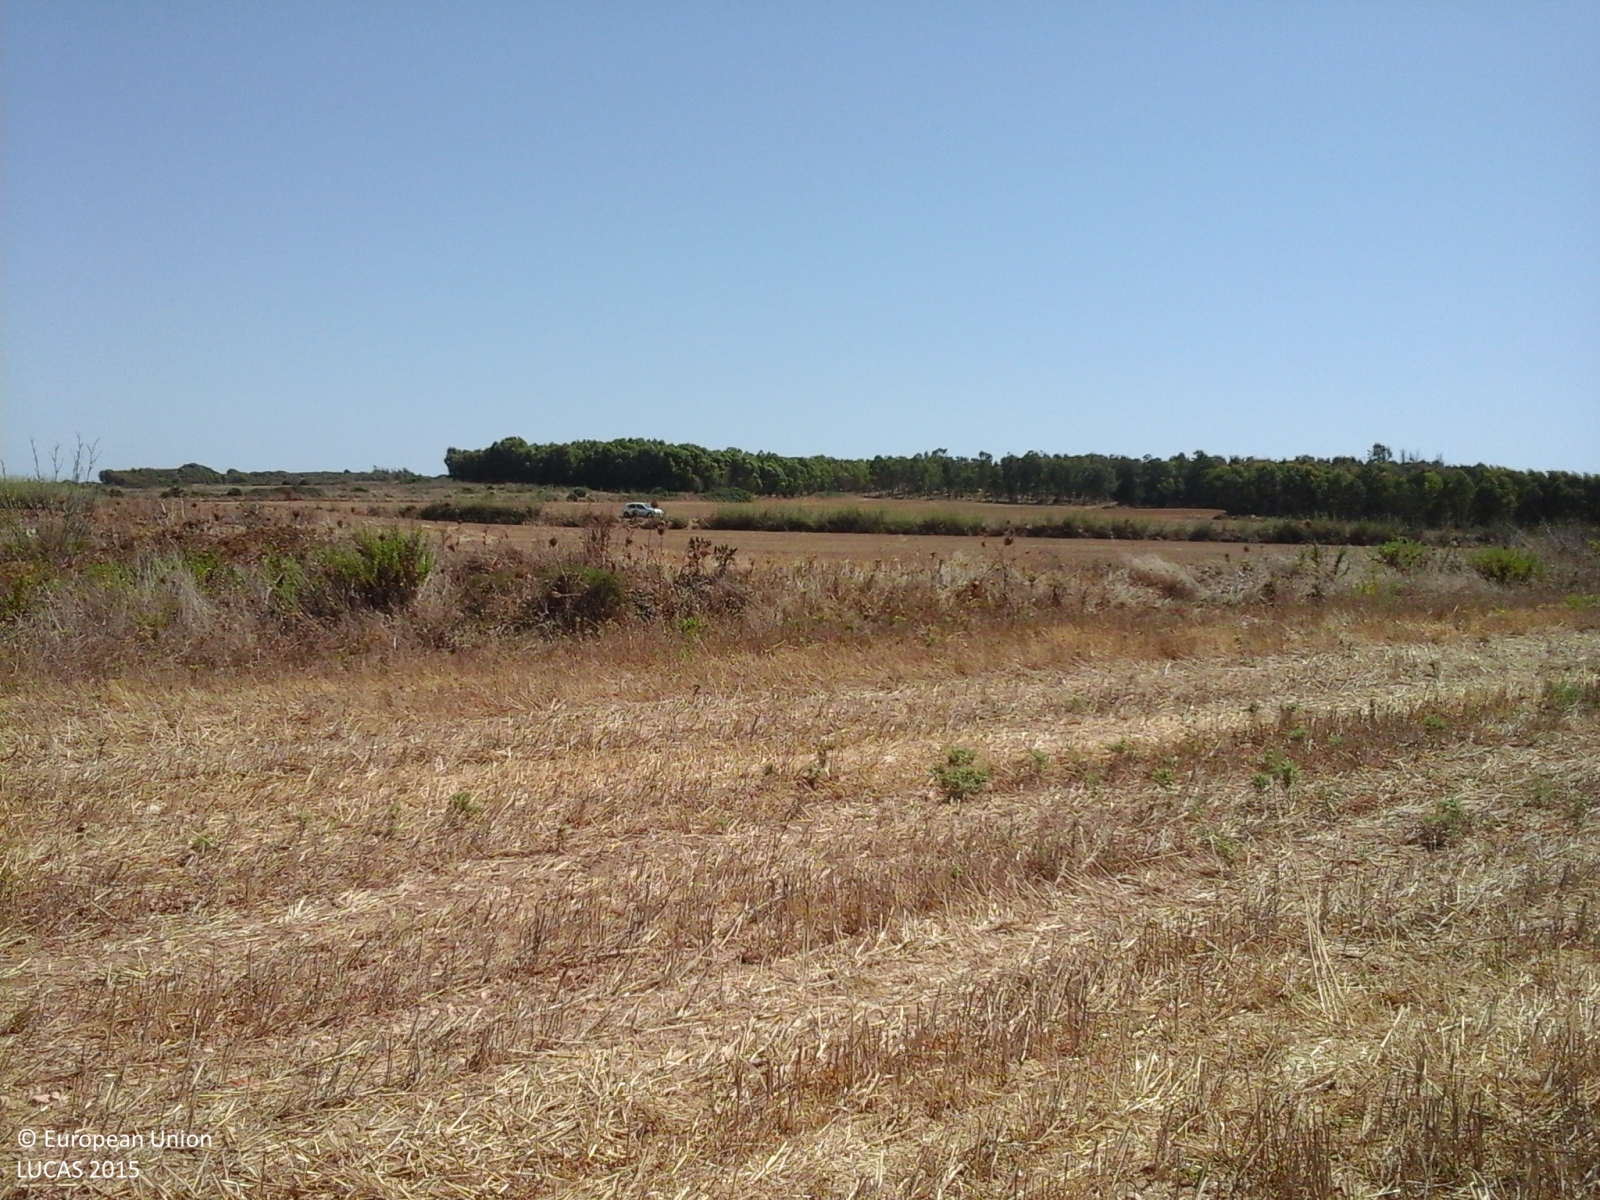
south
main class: Cropland
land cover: Durum wheat
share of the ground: > 75 %
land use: Agriculture (excluding fallow land and kitchen gardens)
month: July
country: IT
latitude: 39.9469
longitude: 8.4286
